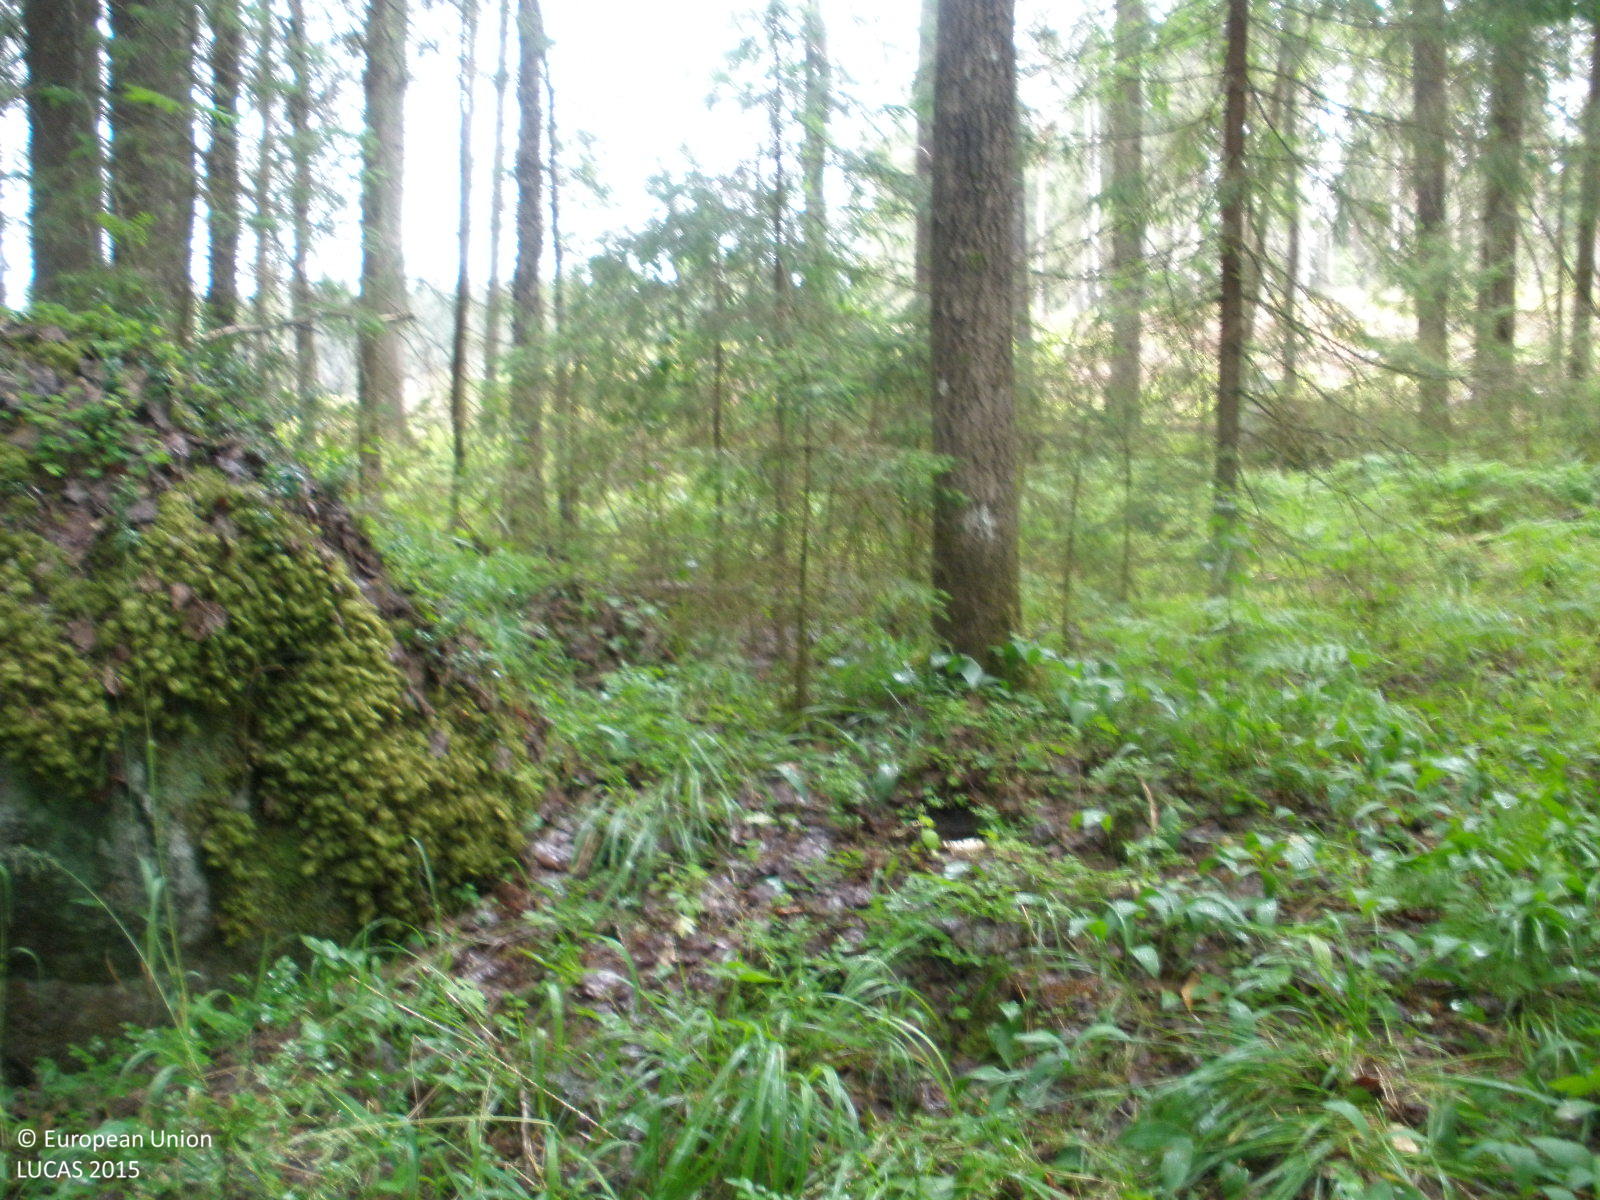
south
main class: Woodland
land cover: Spruce dominated mixed woodland
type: boreal forest
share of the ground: > 75 %
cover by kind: coniferous forest trees 55 %, broadleaved forest trees 30 %, herbaceous plants 15 %
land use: Forestry
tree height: > 5 m
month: July
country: FI
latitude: 61.4138
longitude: 24.8129
